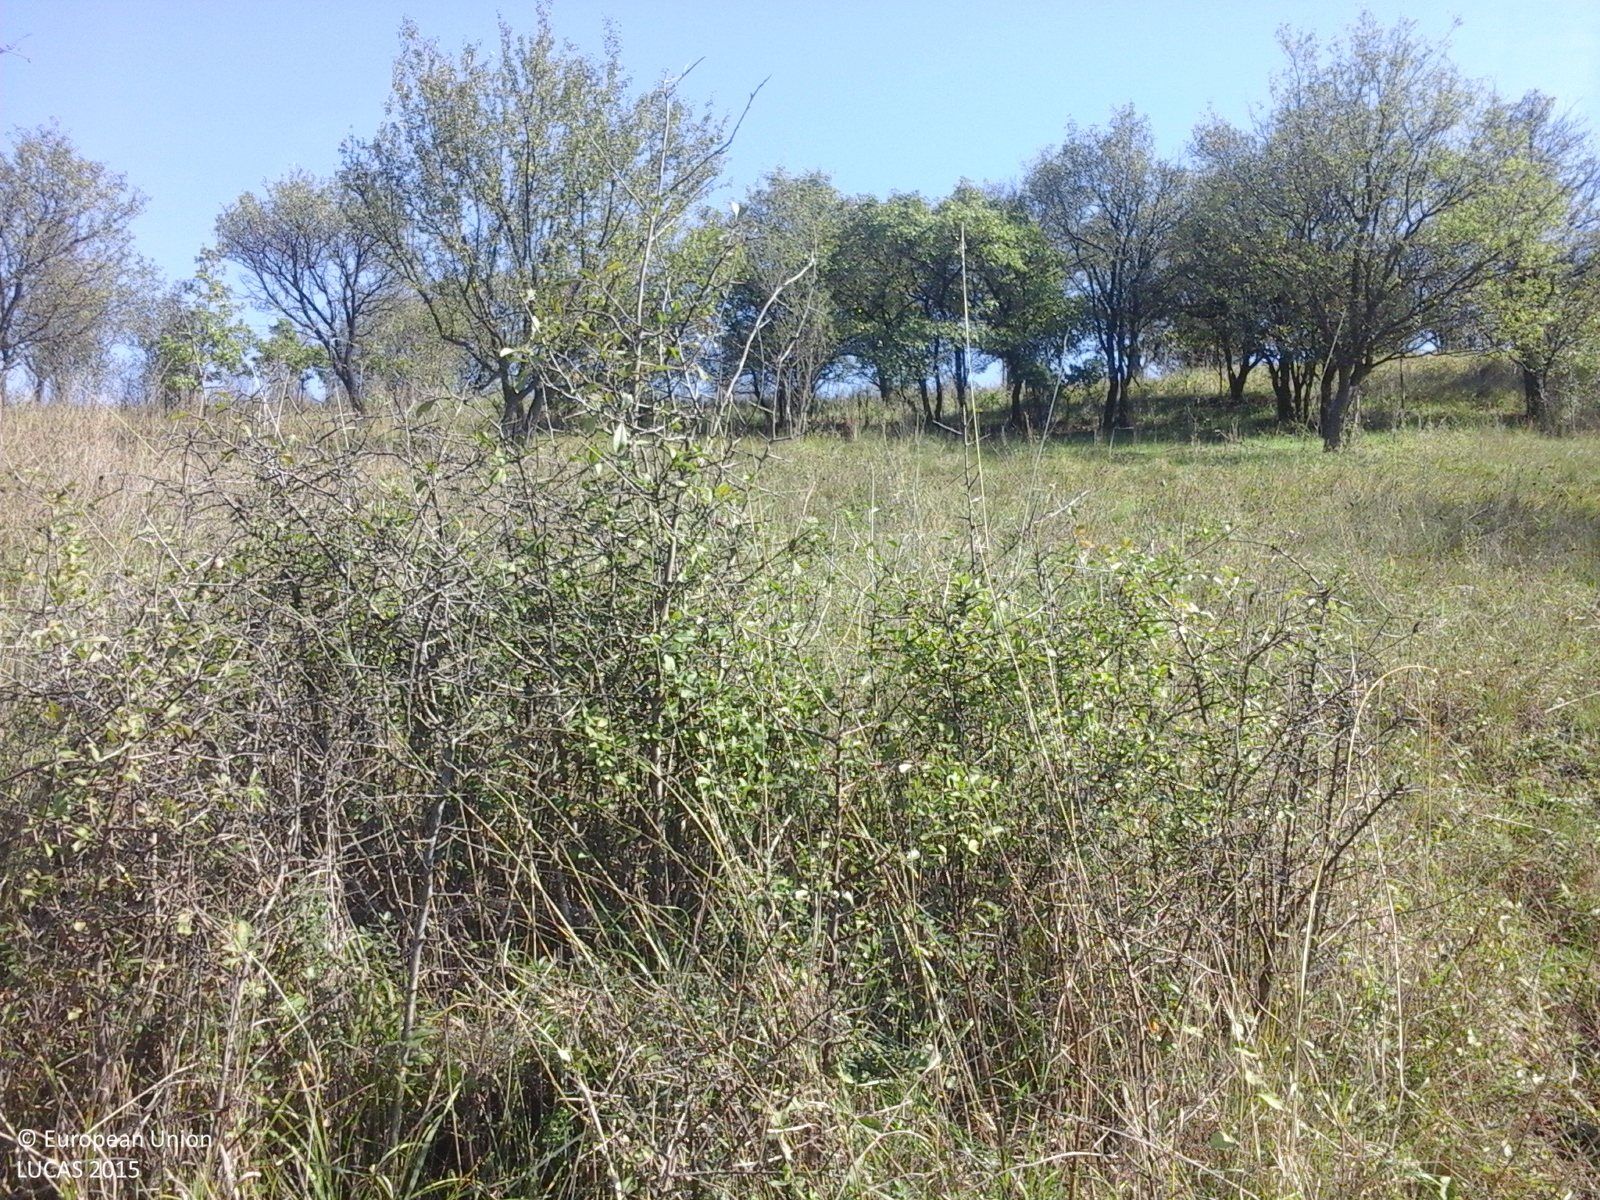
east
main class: Grassland
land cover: Grassland with sparse tree/shrub cover
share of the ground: > 75 %
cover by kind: herbaceous plants 85 %, shrubs 10 %, broadleaved forest trees 5 %
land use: Fallow land
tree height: < 5 m
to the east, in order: Grassland with sparse tree/shrub cover; Other fruit trees and berries; Grassland with sparse tree/shrub cover
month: October
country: RO
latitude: 46.2715
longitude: 23.8135
